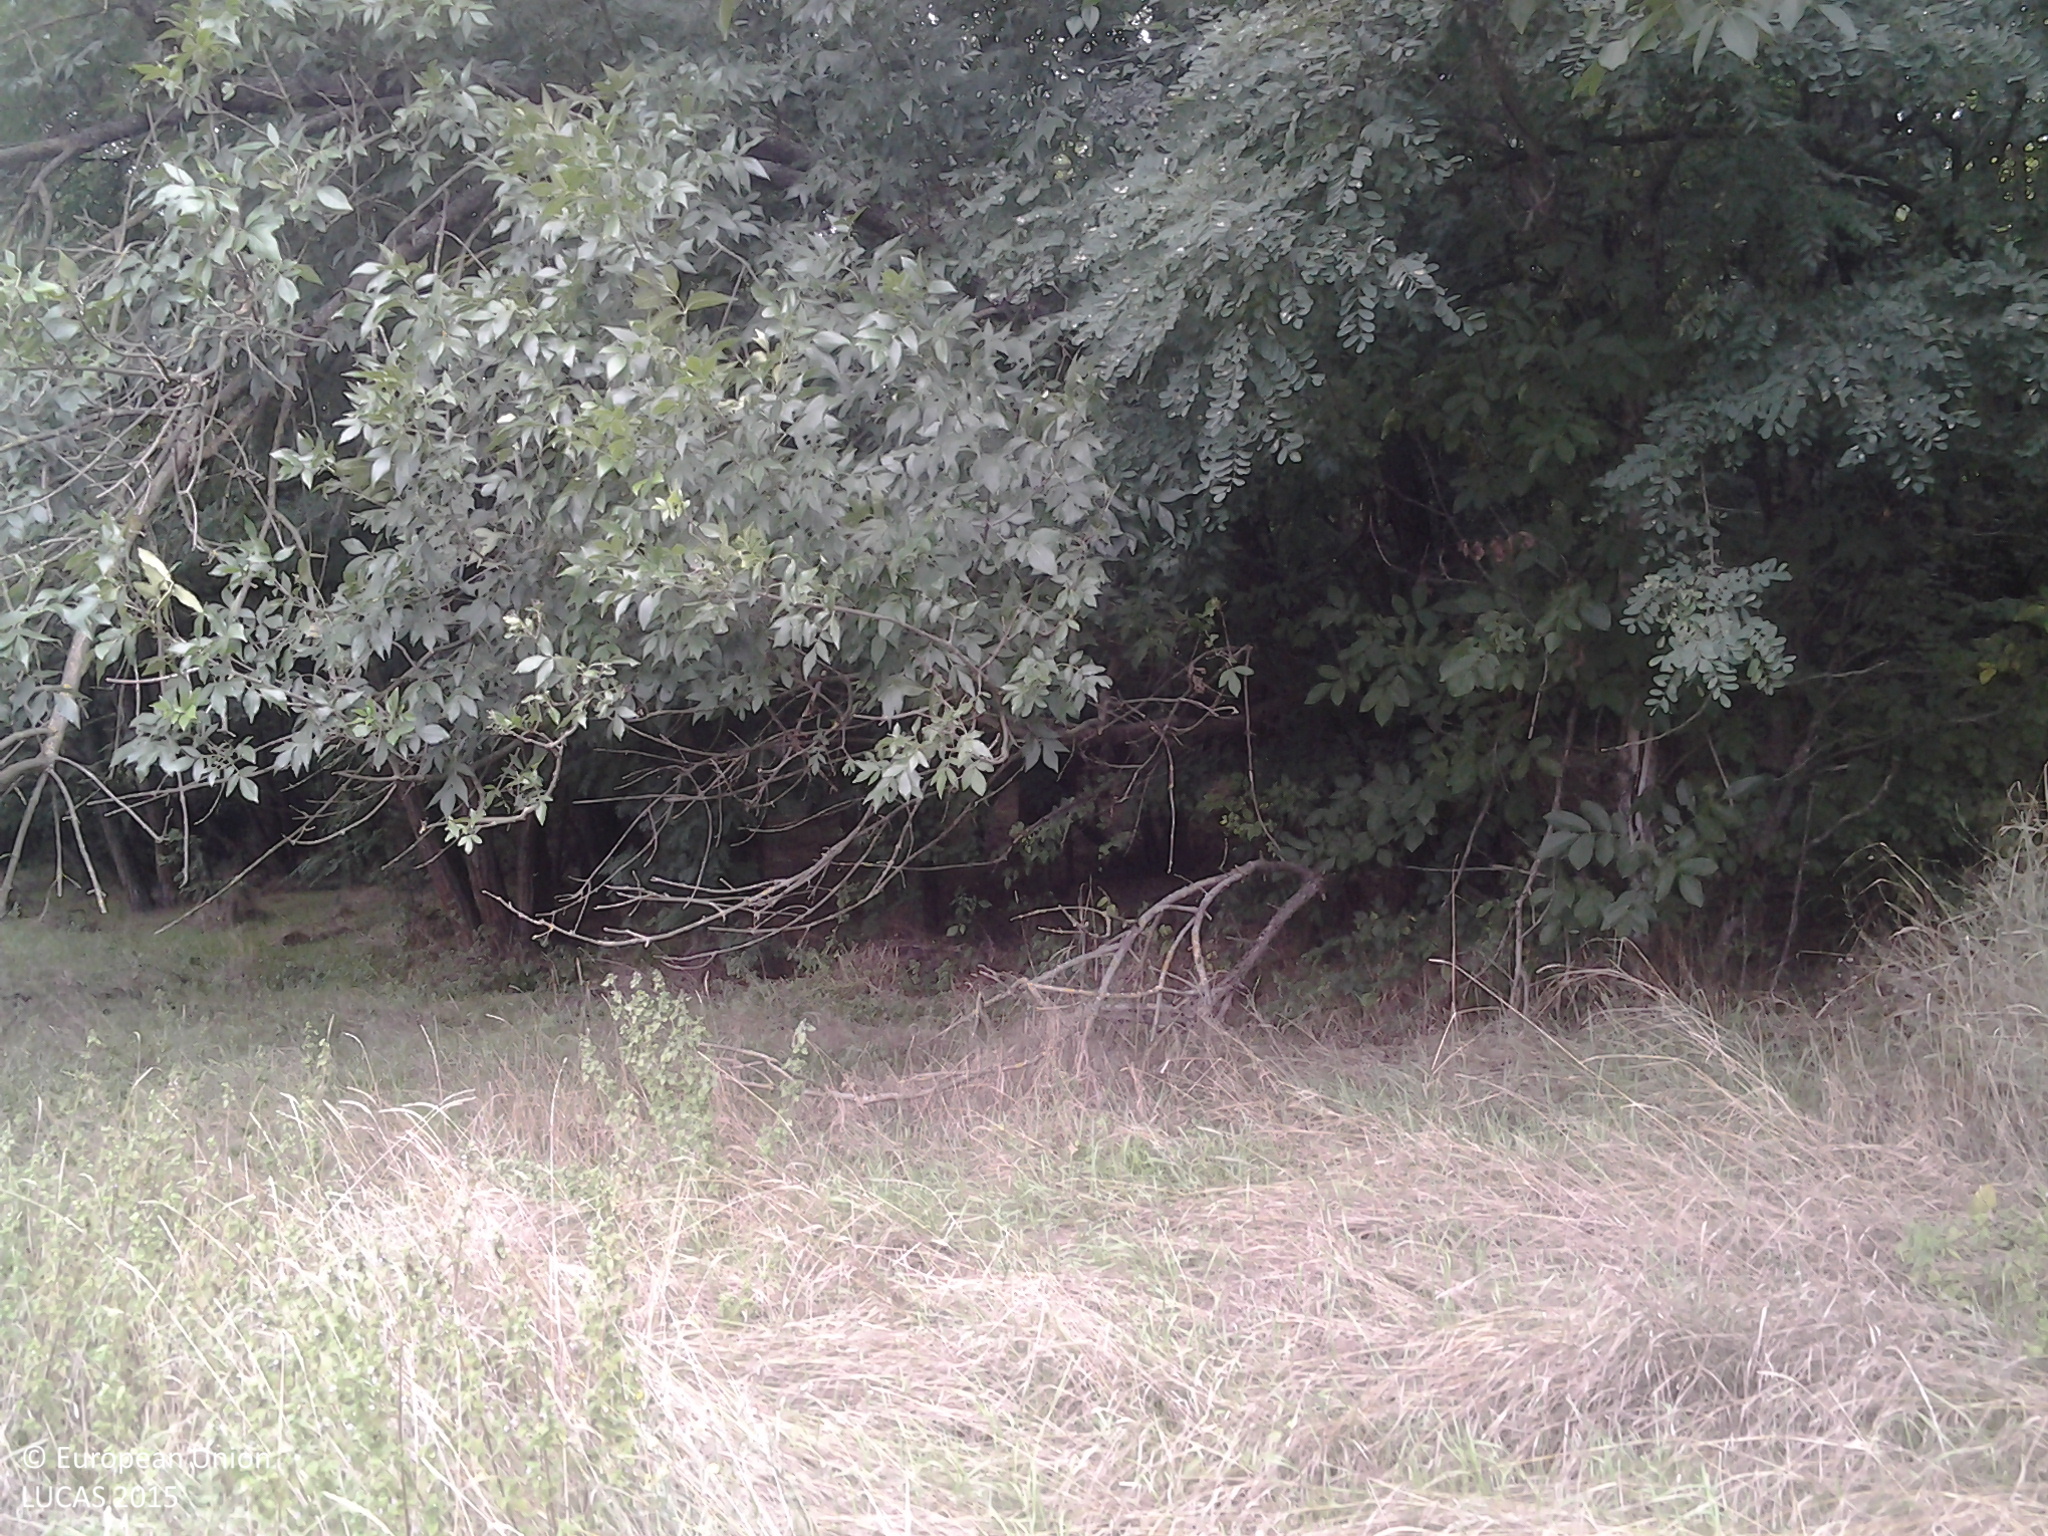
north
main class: Woodland
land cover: Broadleaved woodland
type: mesophytic deciduous forest
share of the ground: > 75 %
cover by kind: broadleaved forest trees 80 %, herbaceous plants 15 %, shrubs 5 %
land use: Forestry
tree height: > 5 m
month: August
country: HU
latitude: 46.0507
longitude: 18.9160
